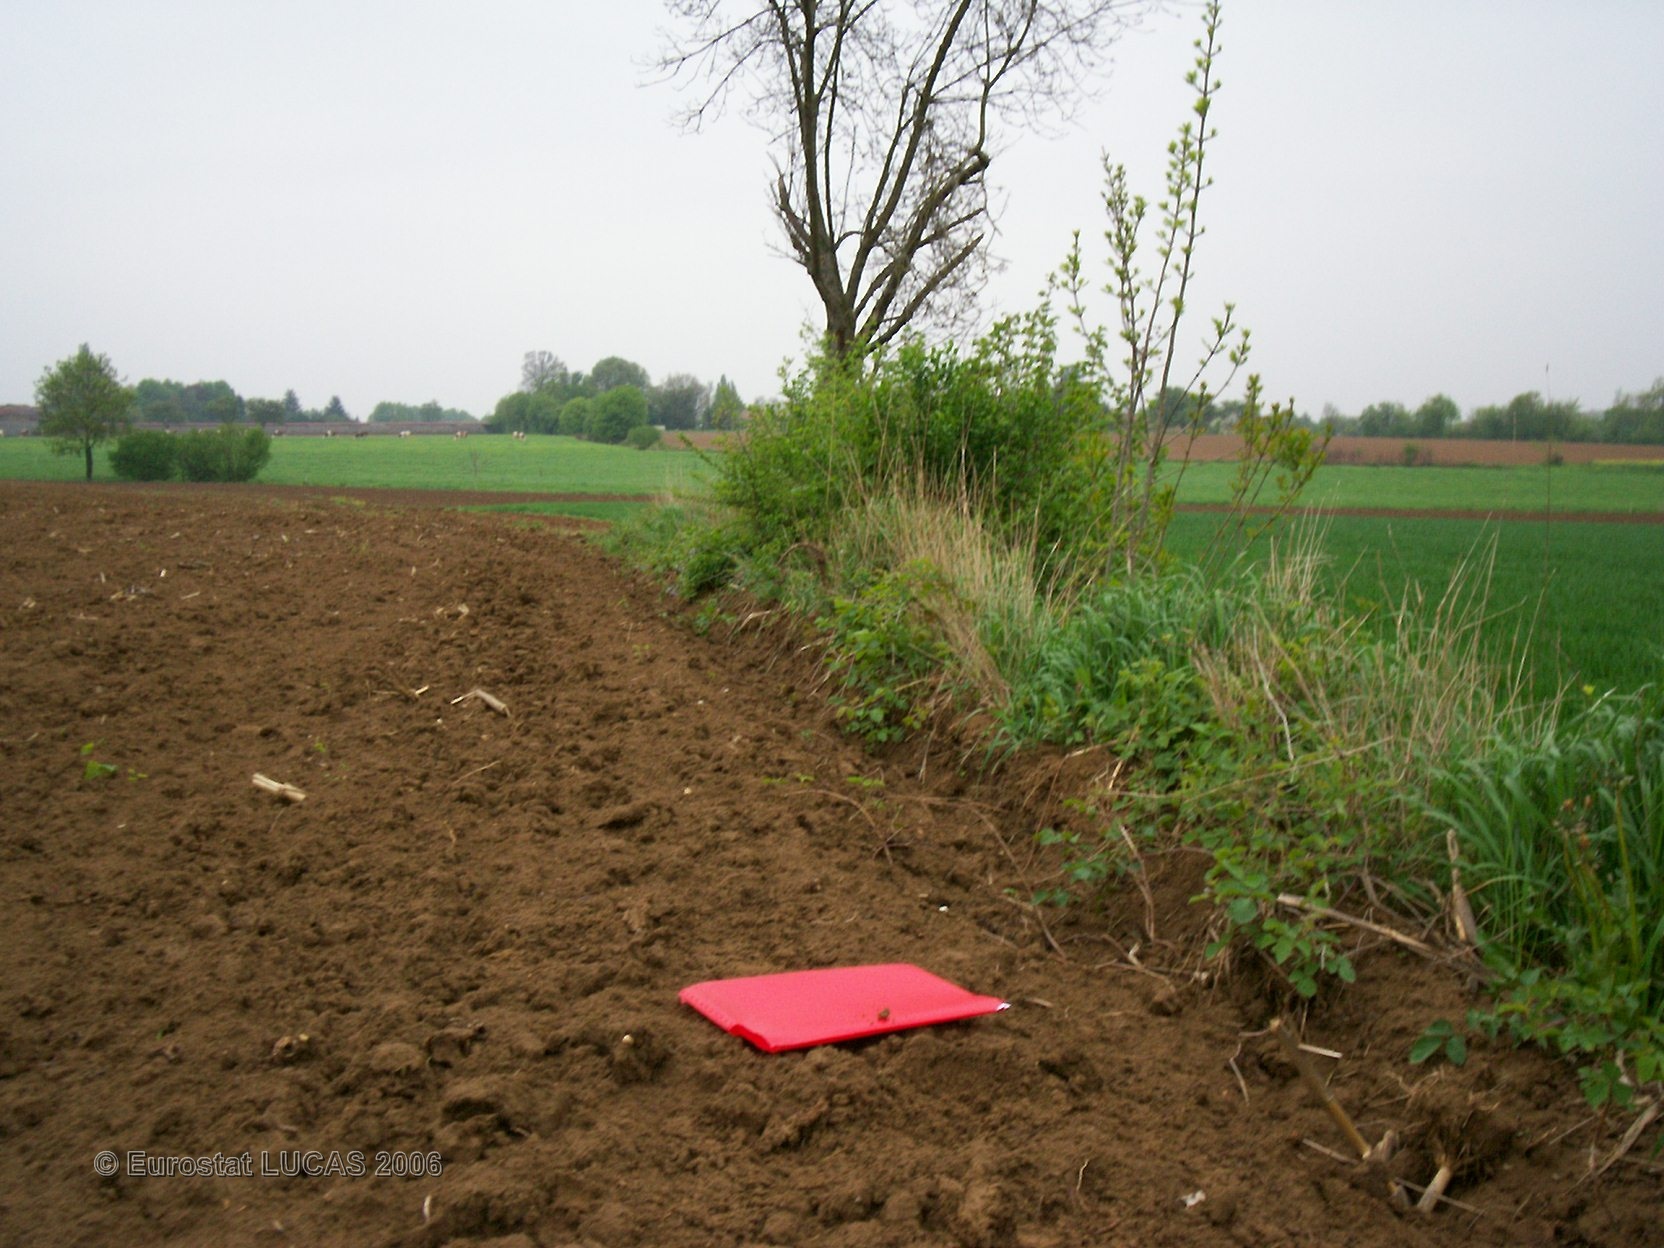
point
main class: Cropland
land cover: Maize
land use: Agriculture (excluding fallow land and kitchen gardens)
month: June
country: FR
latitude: 46.0428
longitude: 4.7692
